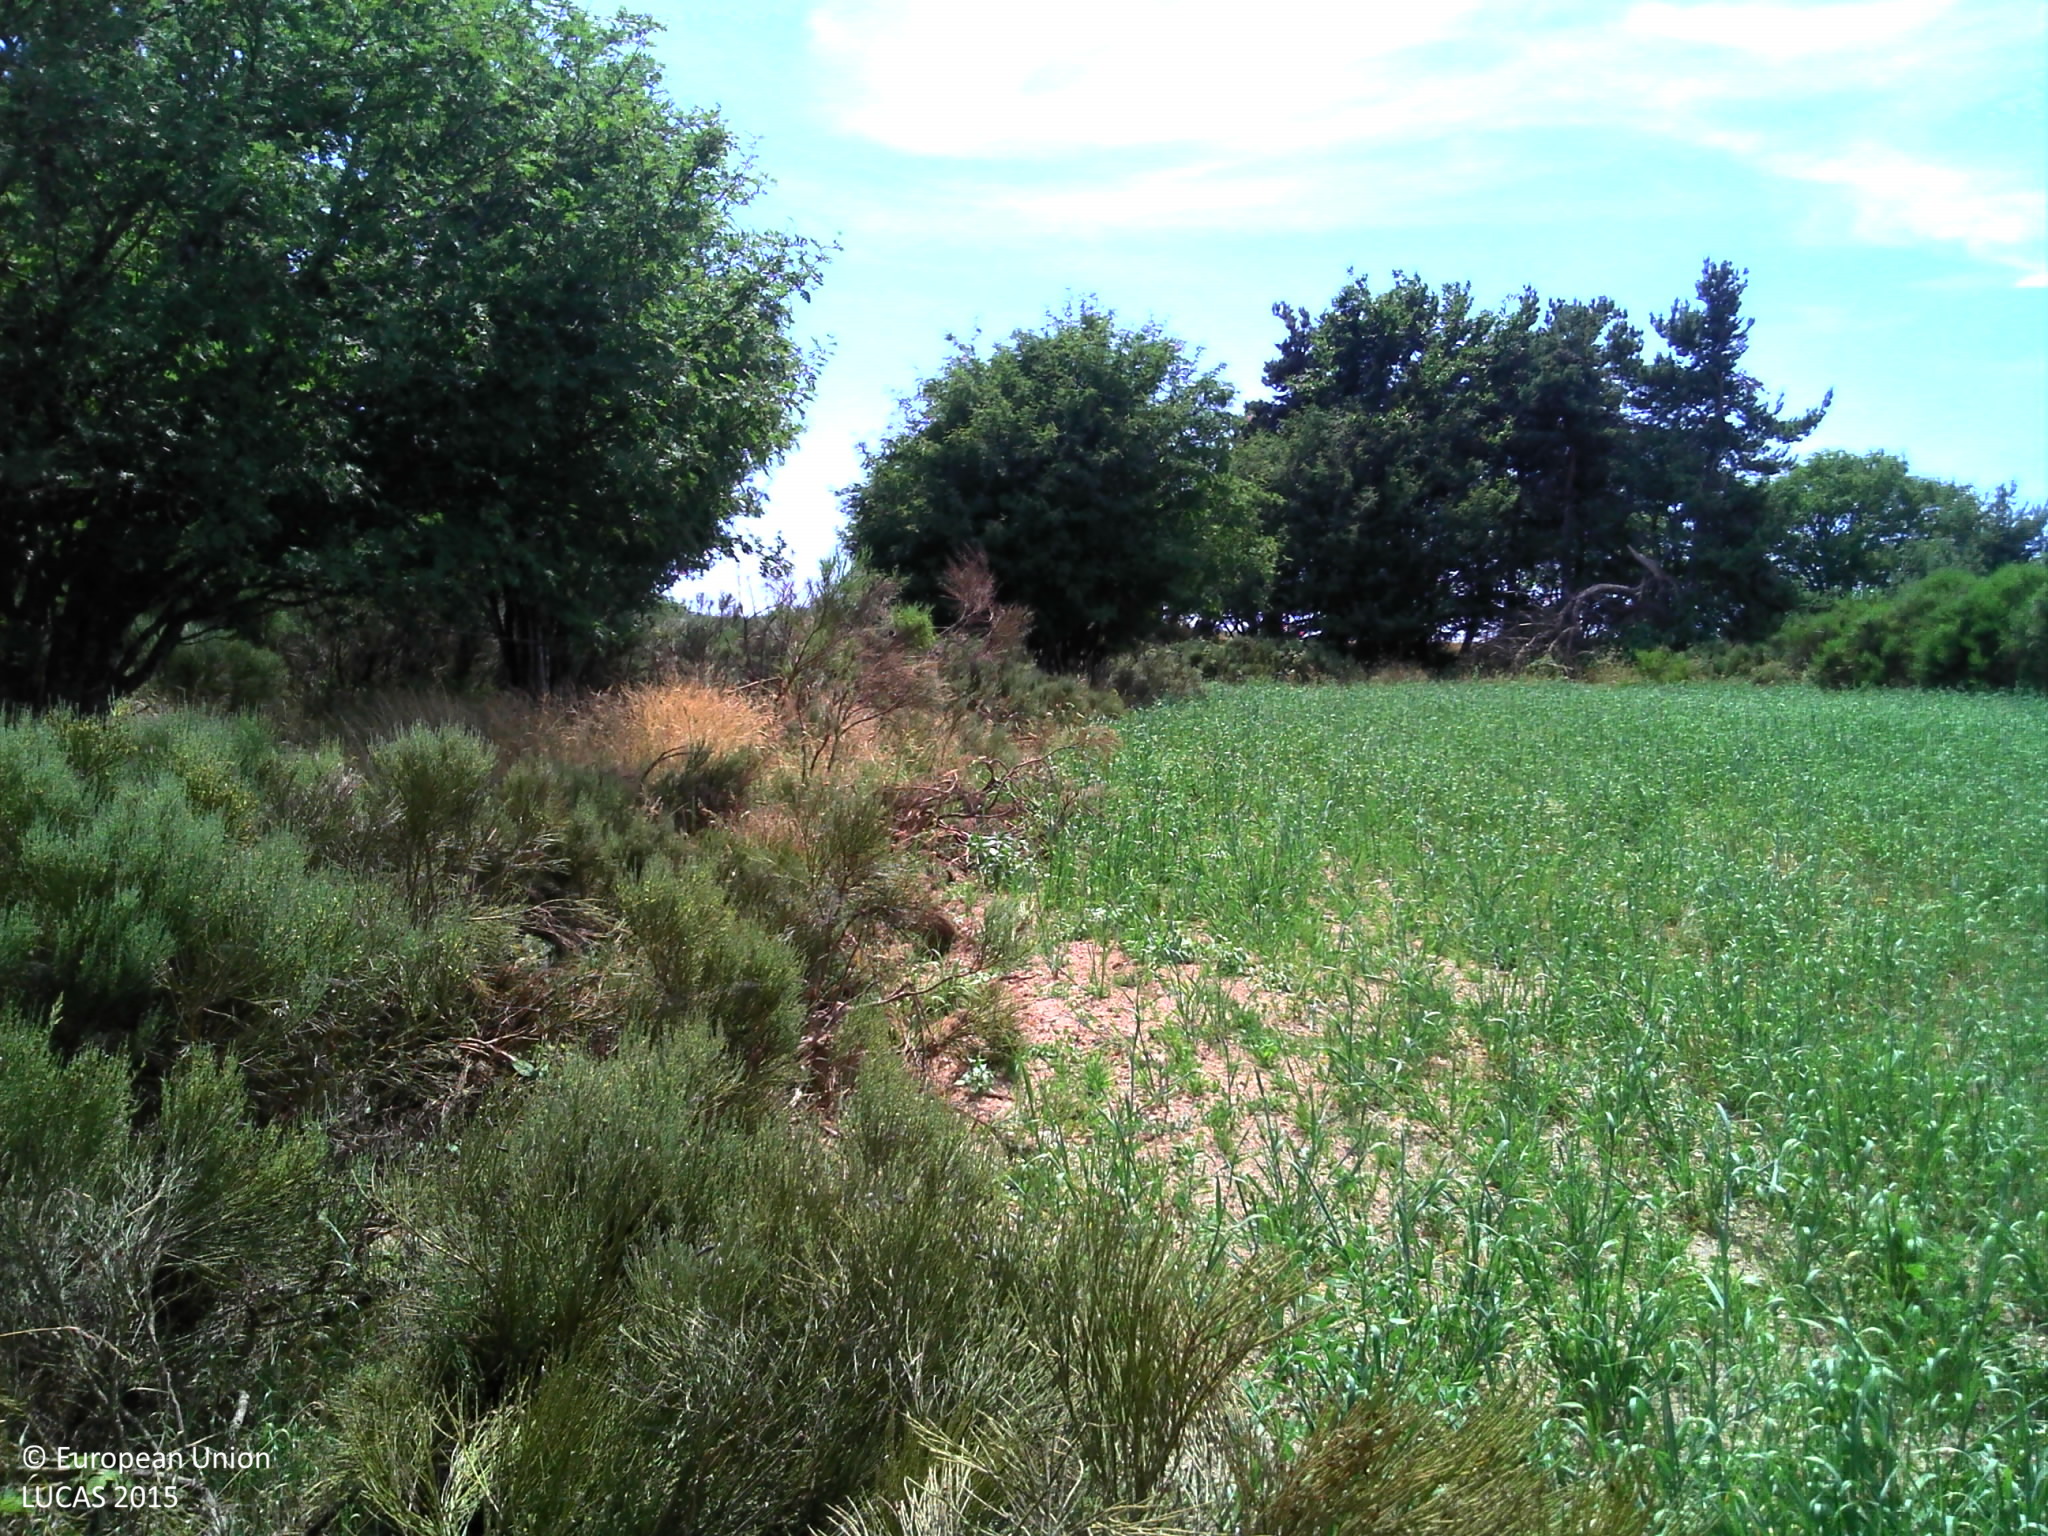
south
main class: Cropland
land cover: Oats
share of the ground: > 75 %
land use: Agriculture (excluding fallow land and kitchen gardens)
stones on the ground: < 10 %
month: July
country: FR
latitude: 44.8692
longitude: 3.4855
